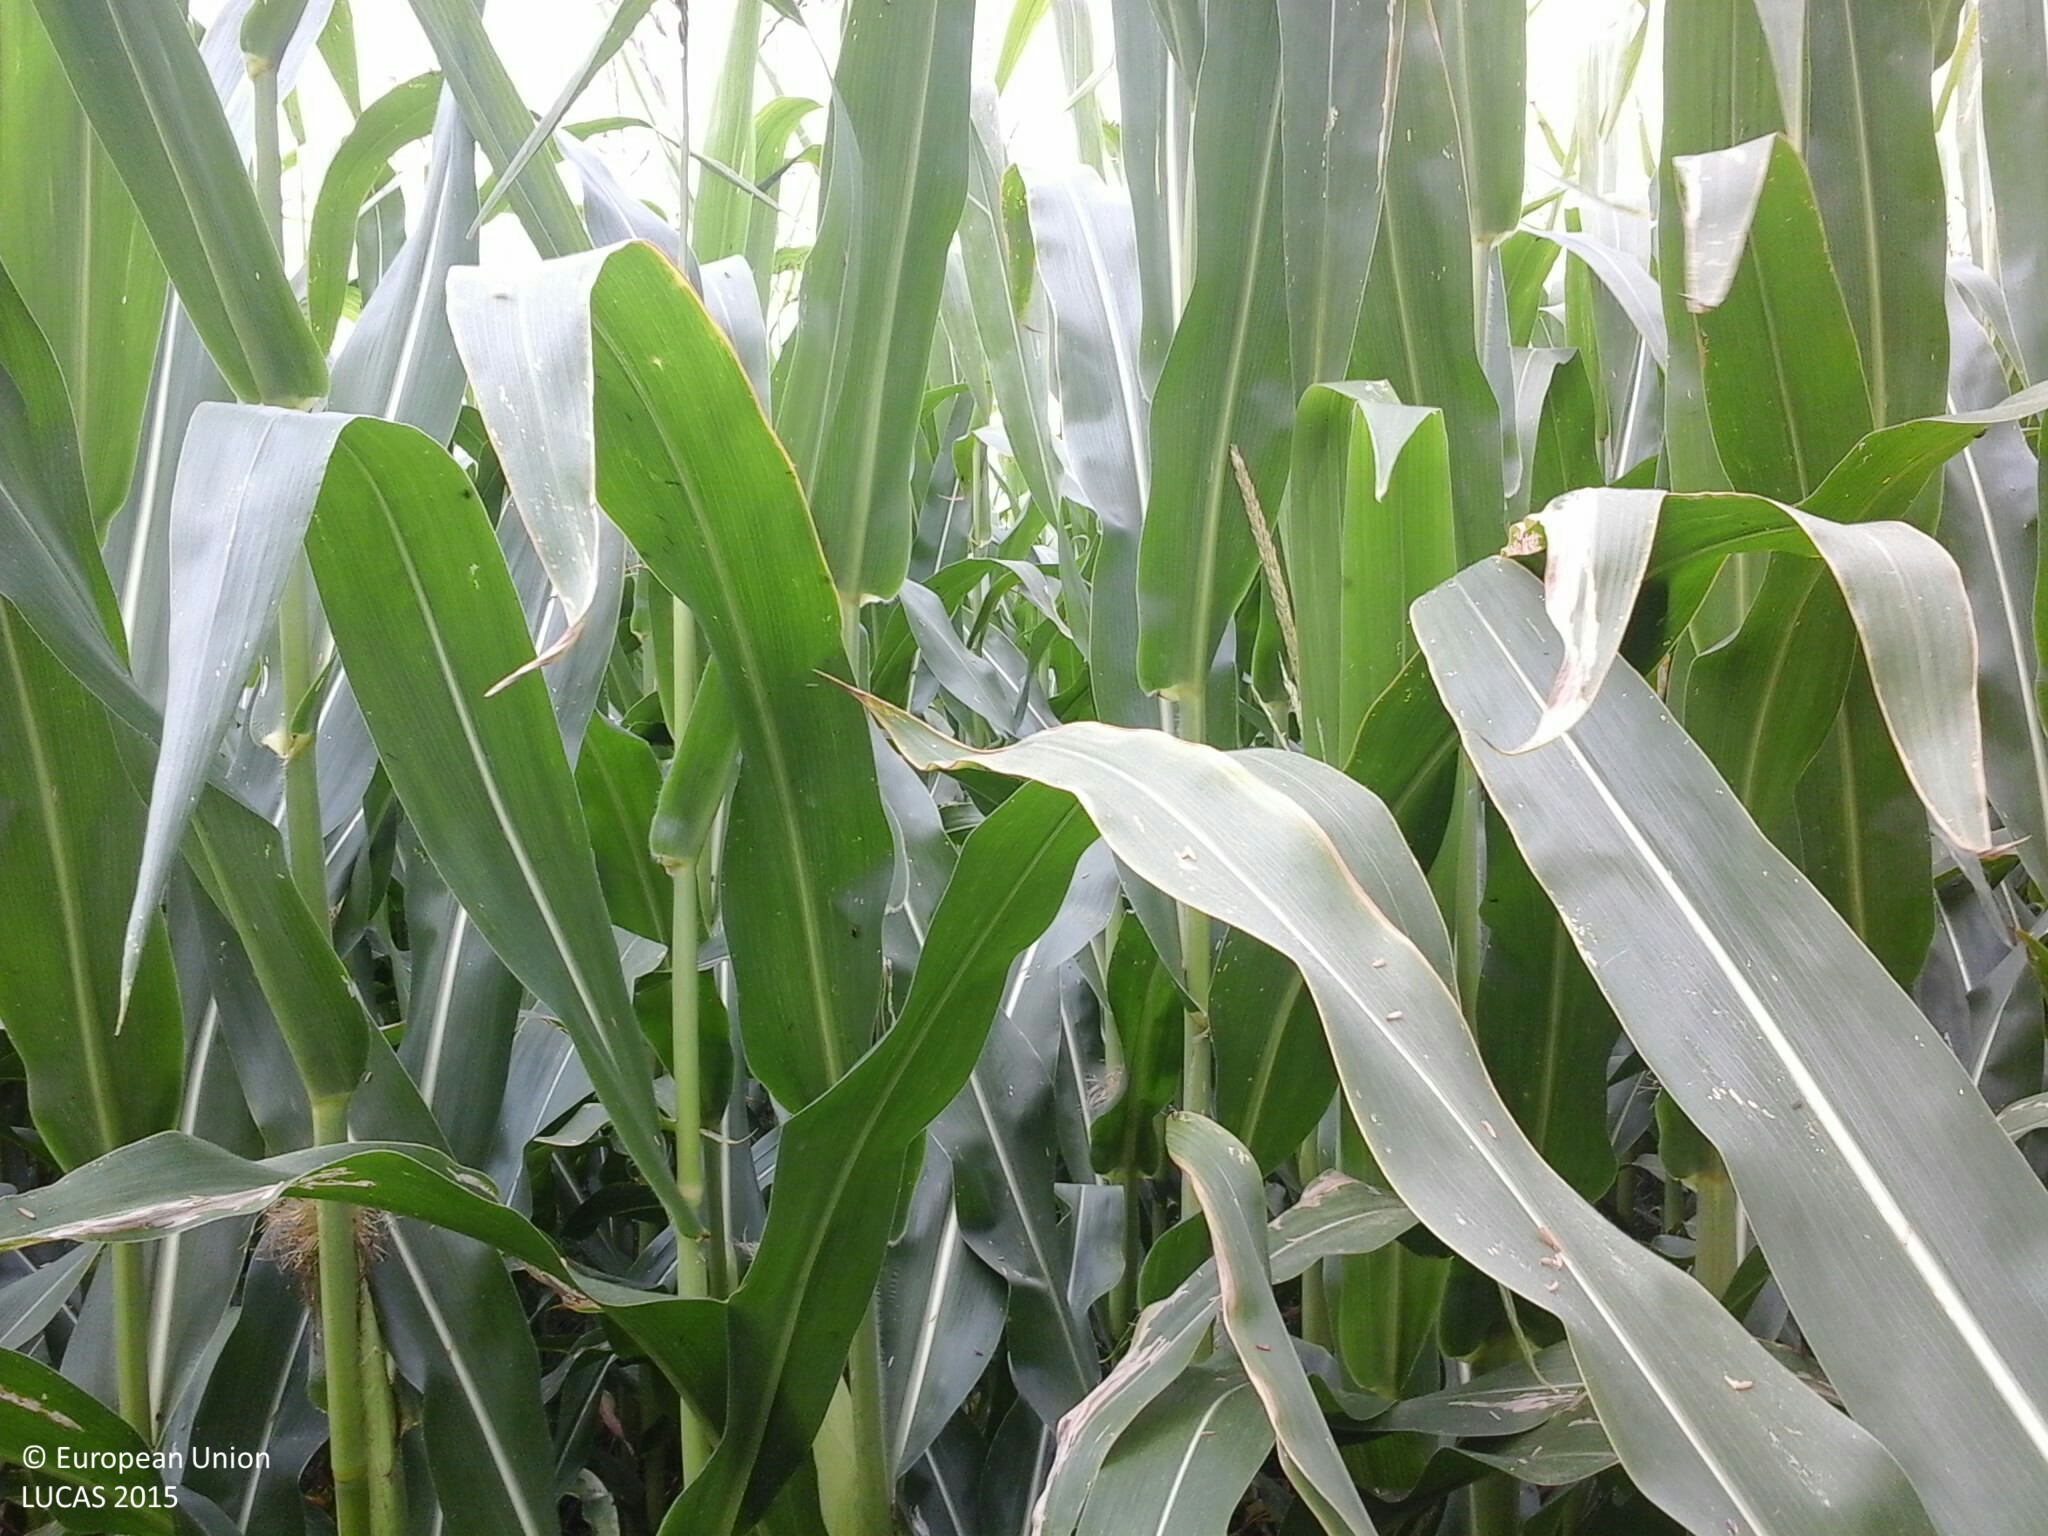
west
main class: Cropland
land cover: Maize
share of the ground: > 75 %
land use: Agriculture (excluding fallow land and kitchen gardens)
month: July
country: HU
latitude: 47.9141
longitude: 22.1362
